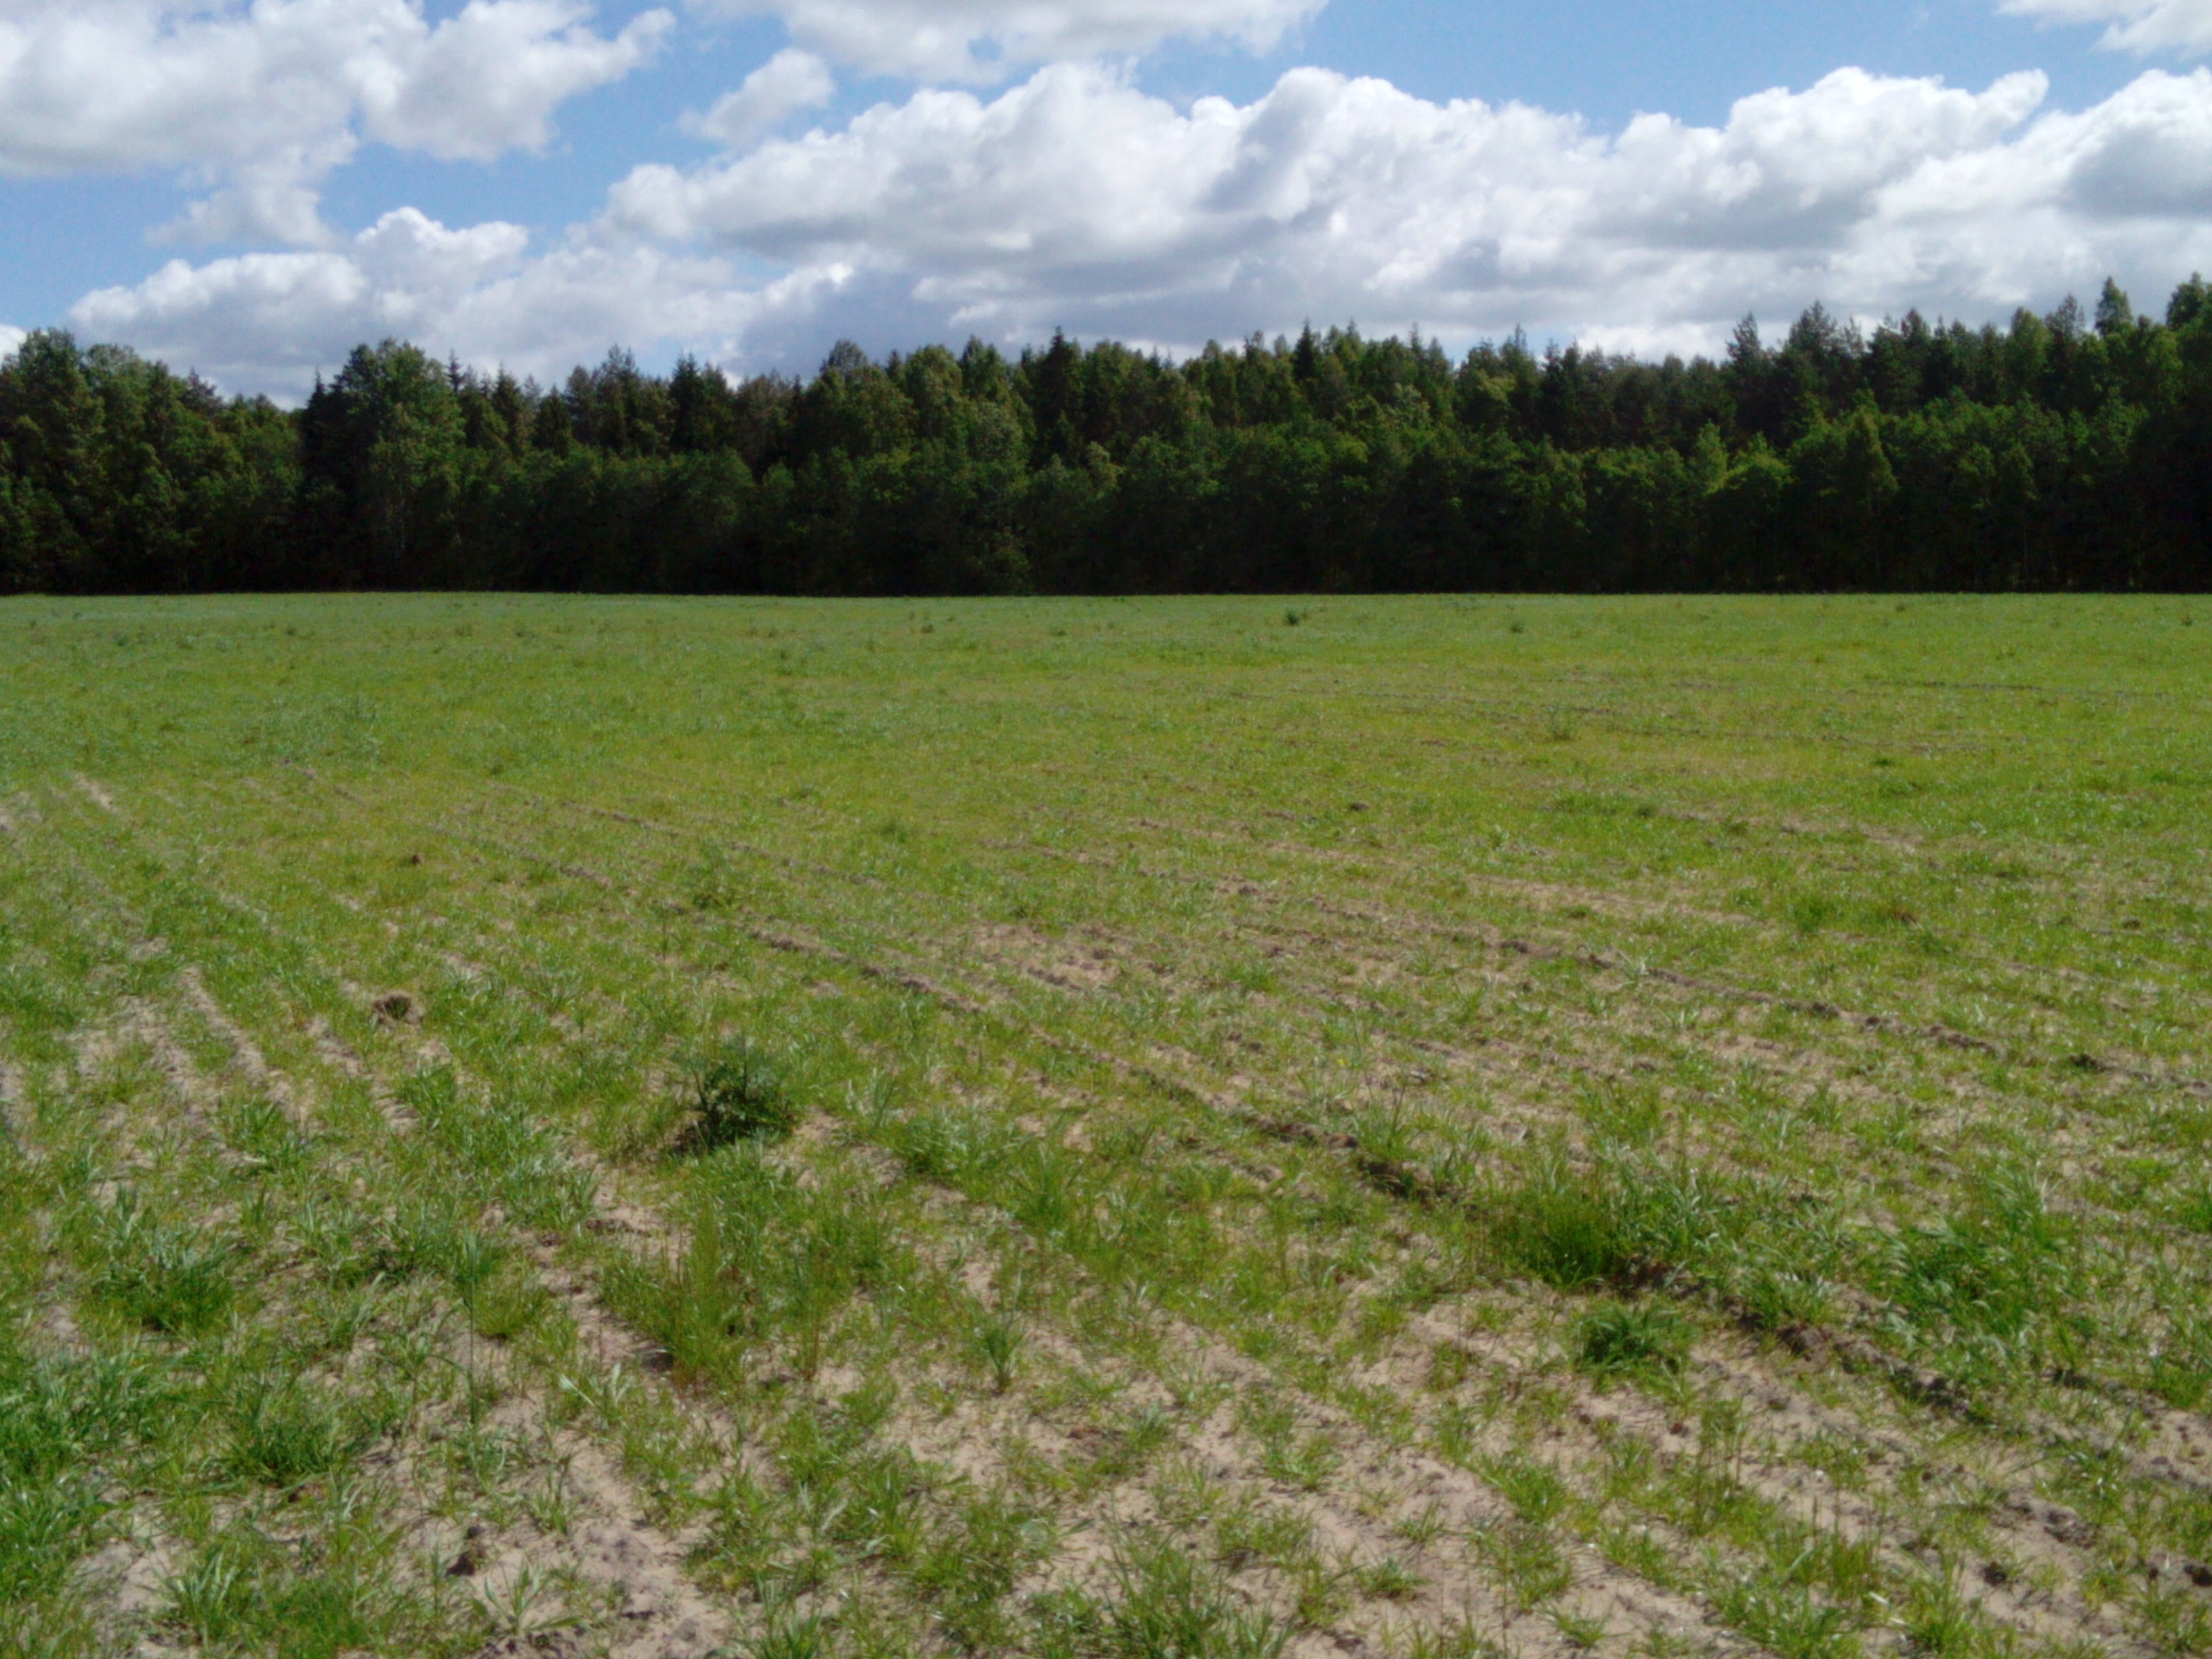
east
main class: Grassland
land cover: Spontaneously vegetated surfaces
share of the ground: 50 - 75 %
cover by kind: herbaceous plants 60 %, unconsolidated bare surface 40 %
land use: Fallow land
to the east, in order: Spontaneously vegetated surfaces; Broadleaved woodland; Ditches and canals; Shruby margins; Spruce dominated mixed woodland
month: June
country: LV
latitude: 56.8182
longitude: 22.0576
